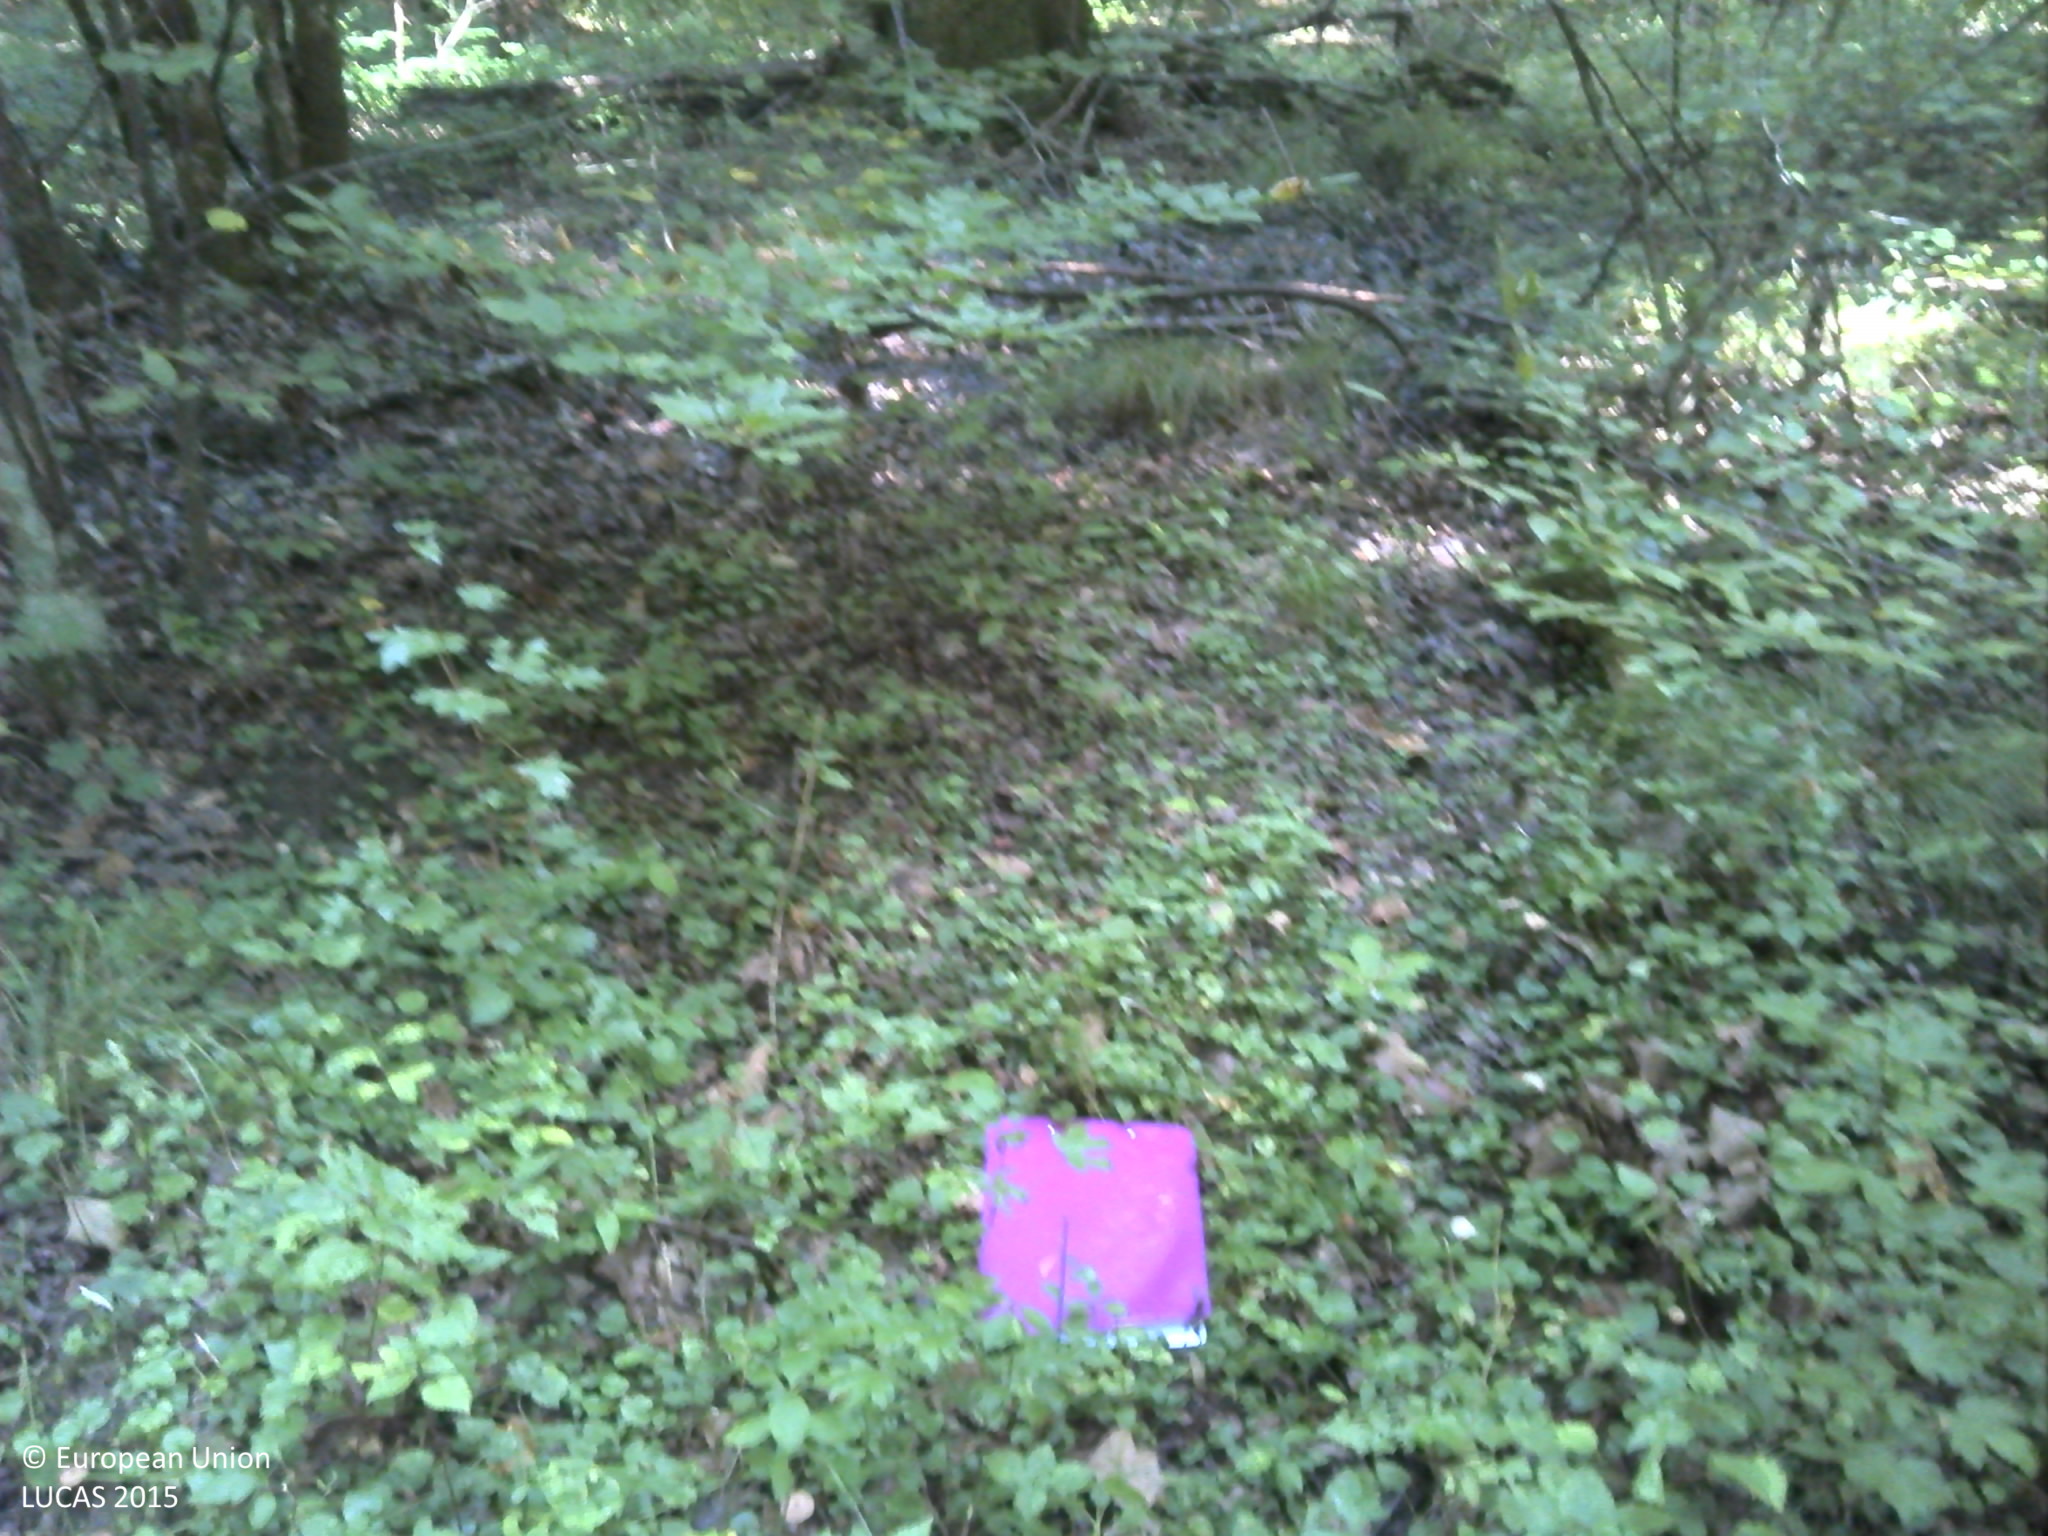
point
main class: Woodland
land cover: Broadleaved woodland
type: acidophilous oak and oak-birch forest
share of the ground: > 75 %
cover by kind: broadleaved forest trees 100 %
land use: Forestry
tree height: > 5 m
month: September
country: HR
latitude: 45.4996
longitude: 16.2556
